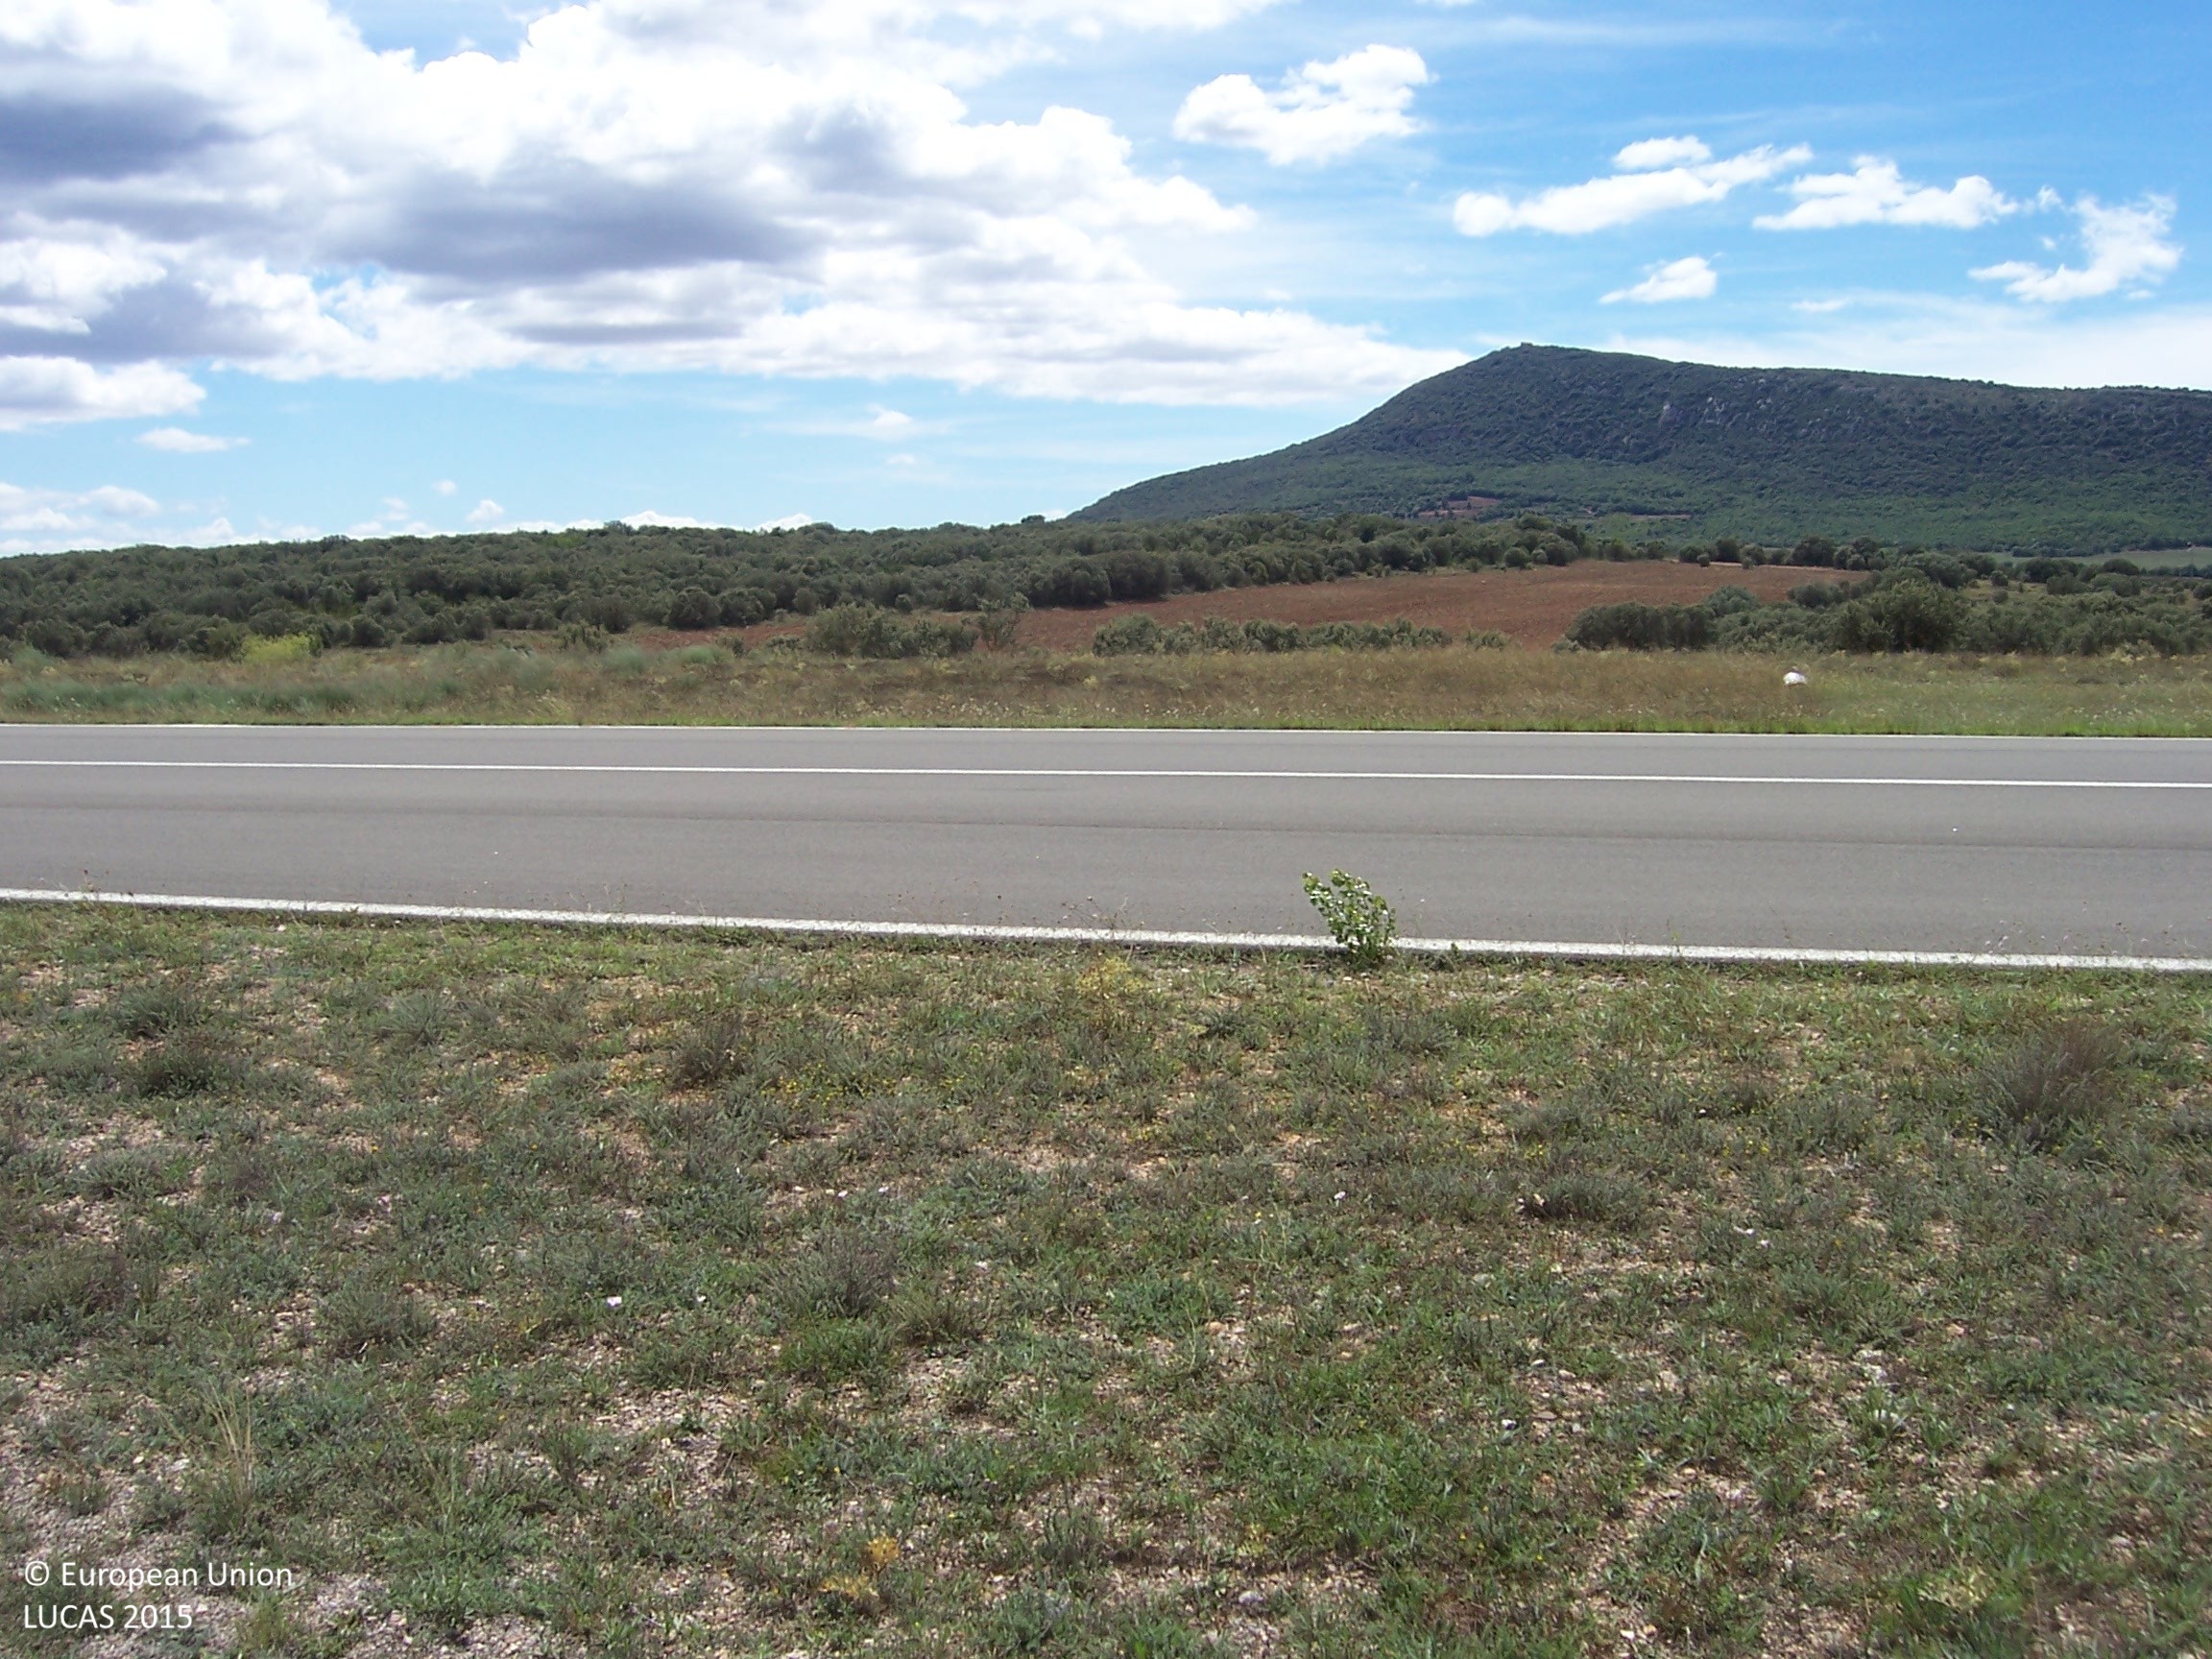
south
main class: Grassland
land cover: Grassland without tree/shrub cover
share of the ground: > 75 %
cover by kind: herbaceous plants 80 %, unconsolidated bare surface 20 %
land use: Air transport
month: August
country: ES
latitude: 42.0228
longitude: 0.4791
